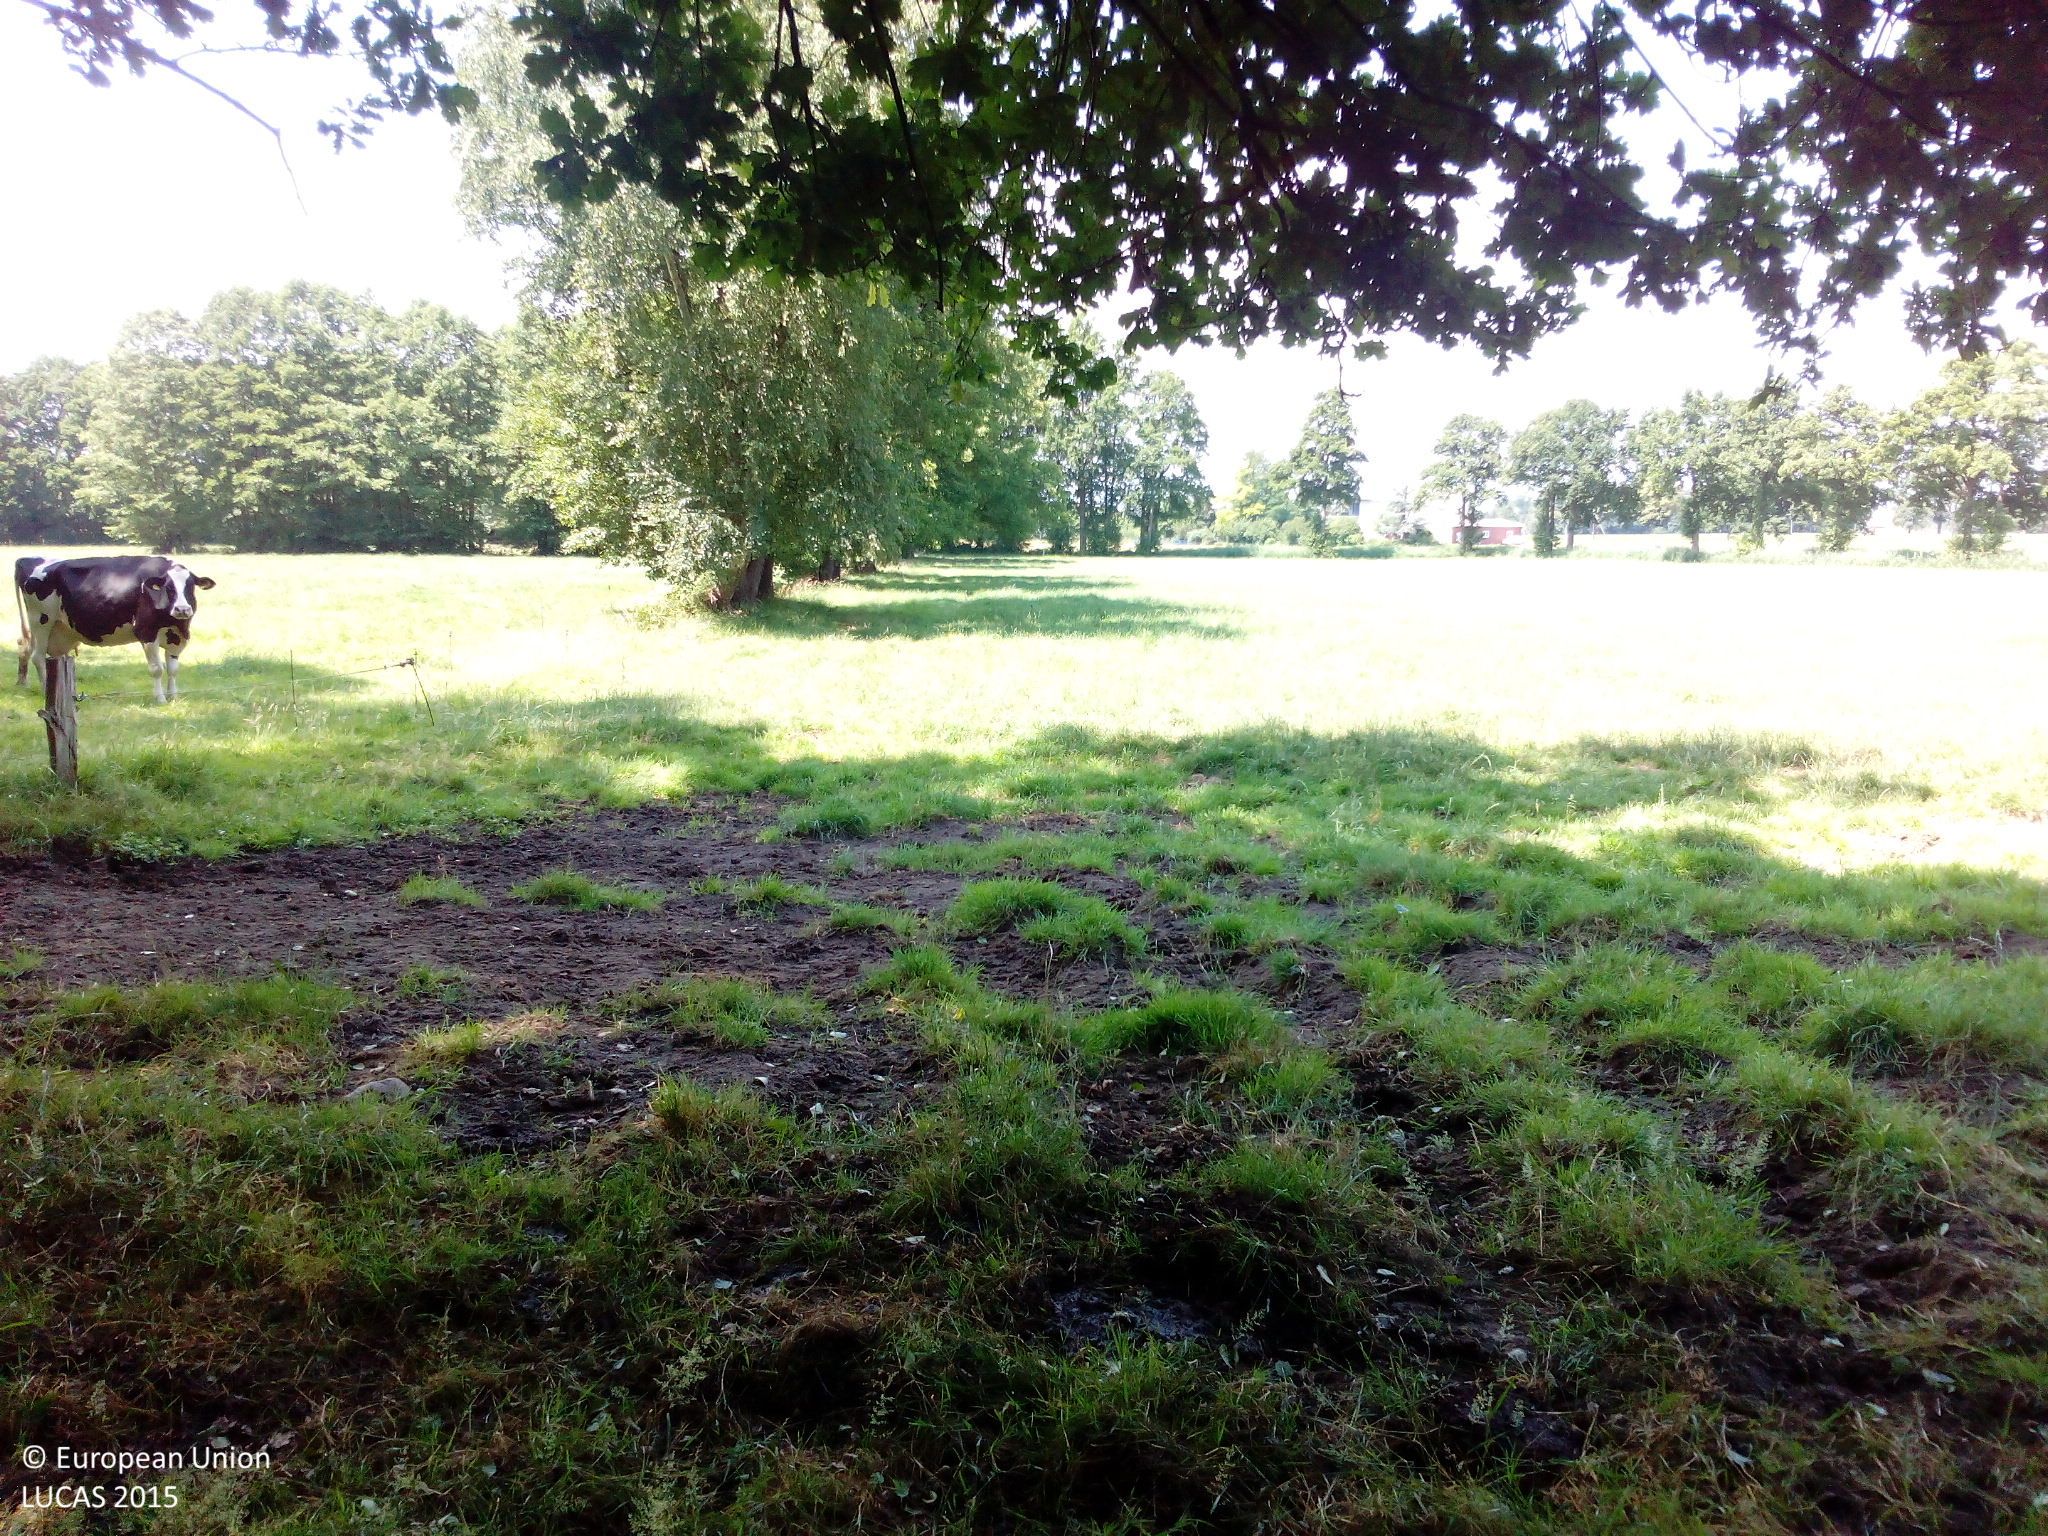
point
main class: Grassland
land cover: Grassland without tree/shrub cover
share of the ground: > 75 %
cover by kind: herbaceous plants 100 %
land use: Agriculture (excluding fallow land and kitchen gardens)
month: July
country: DE
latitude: 51.8460
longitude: 8.4472
